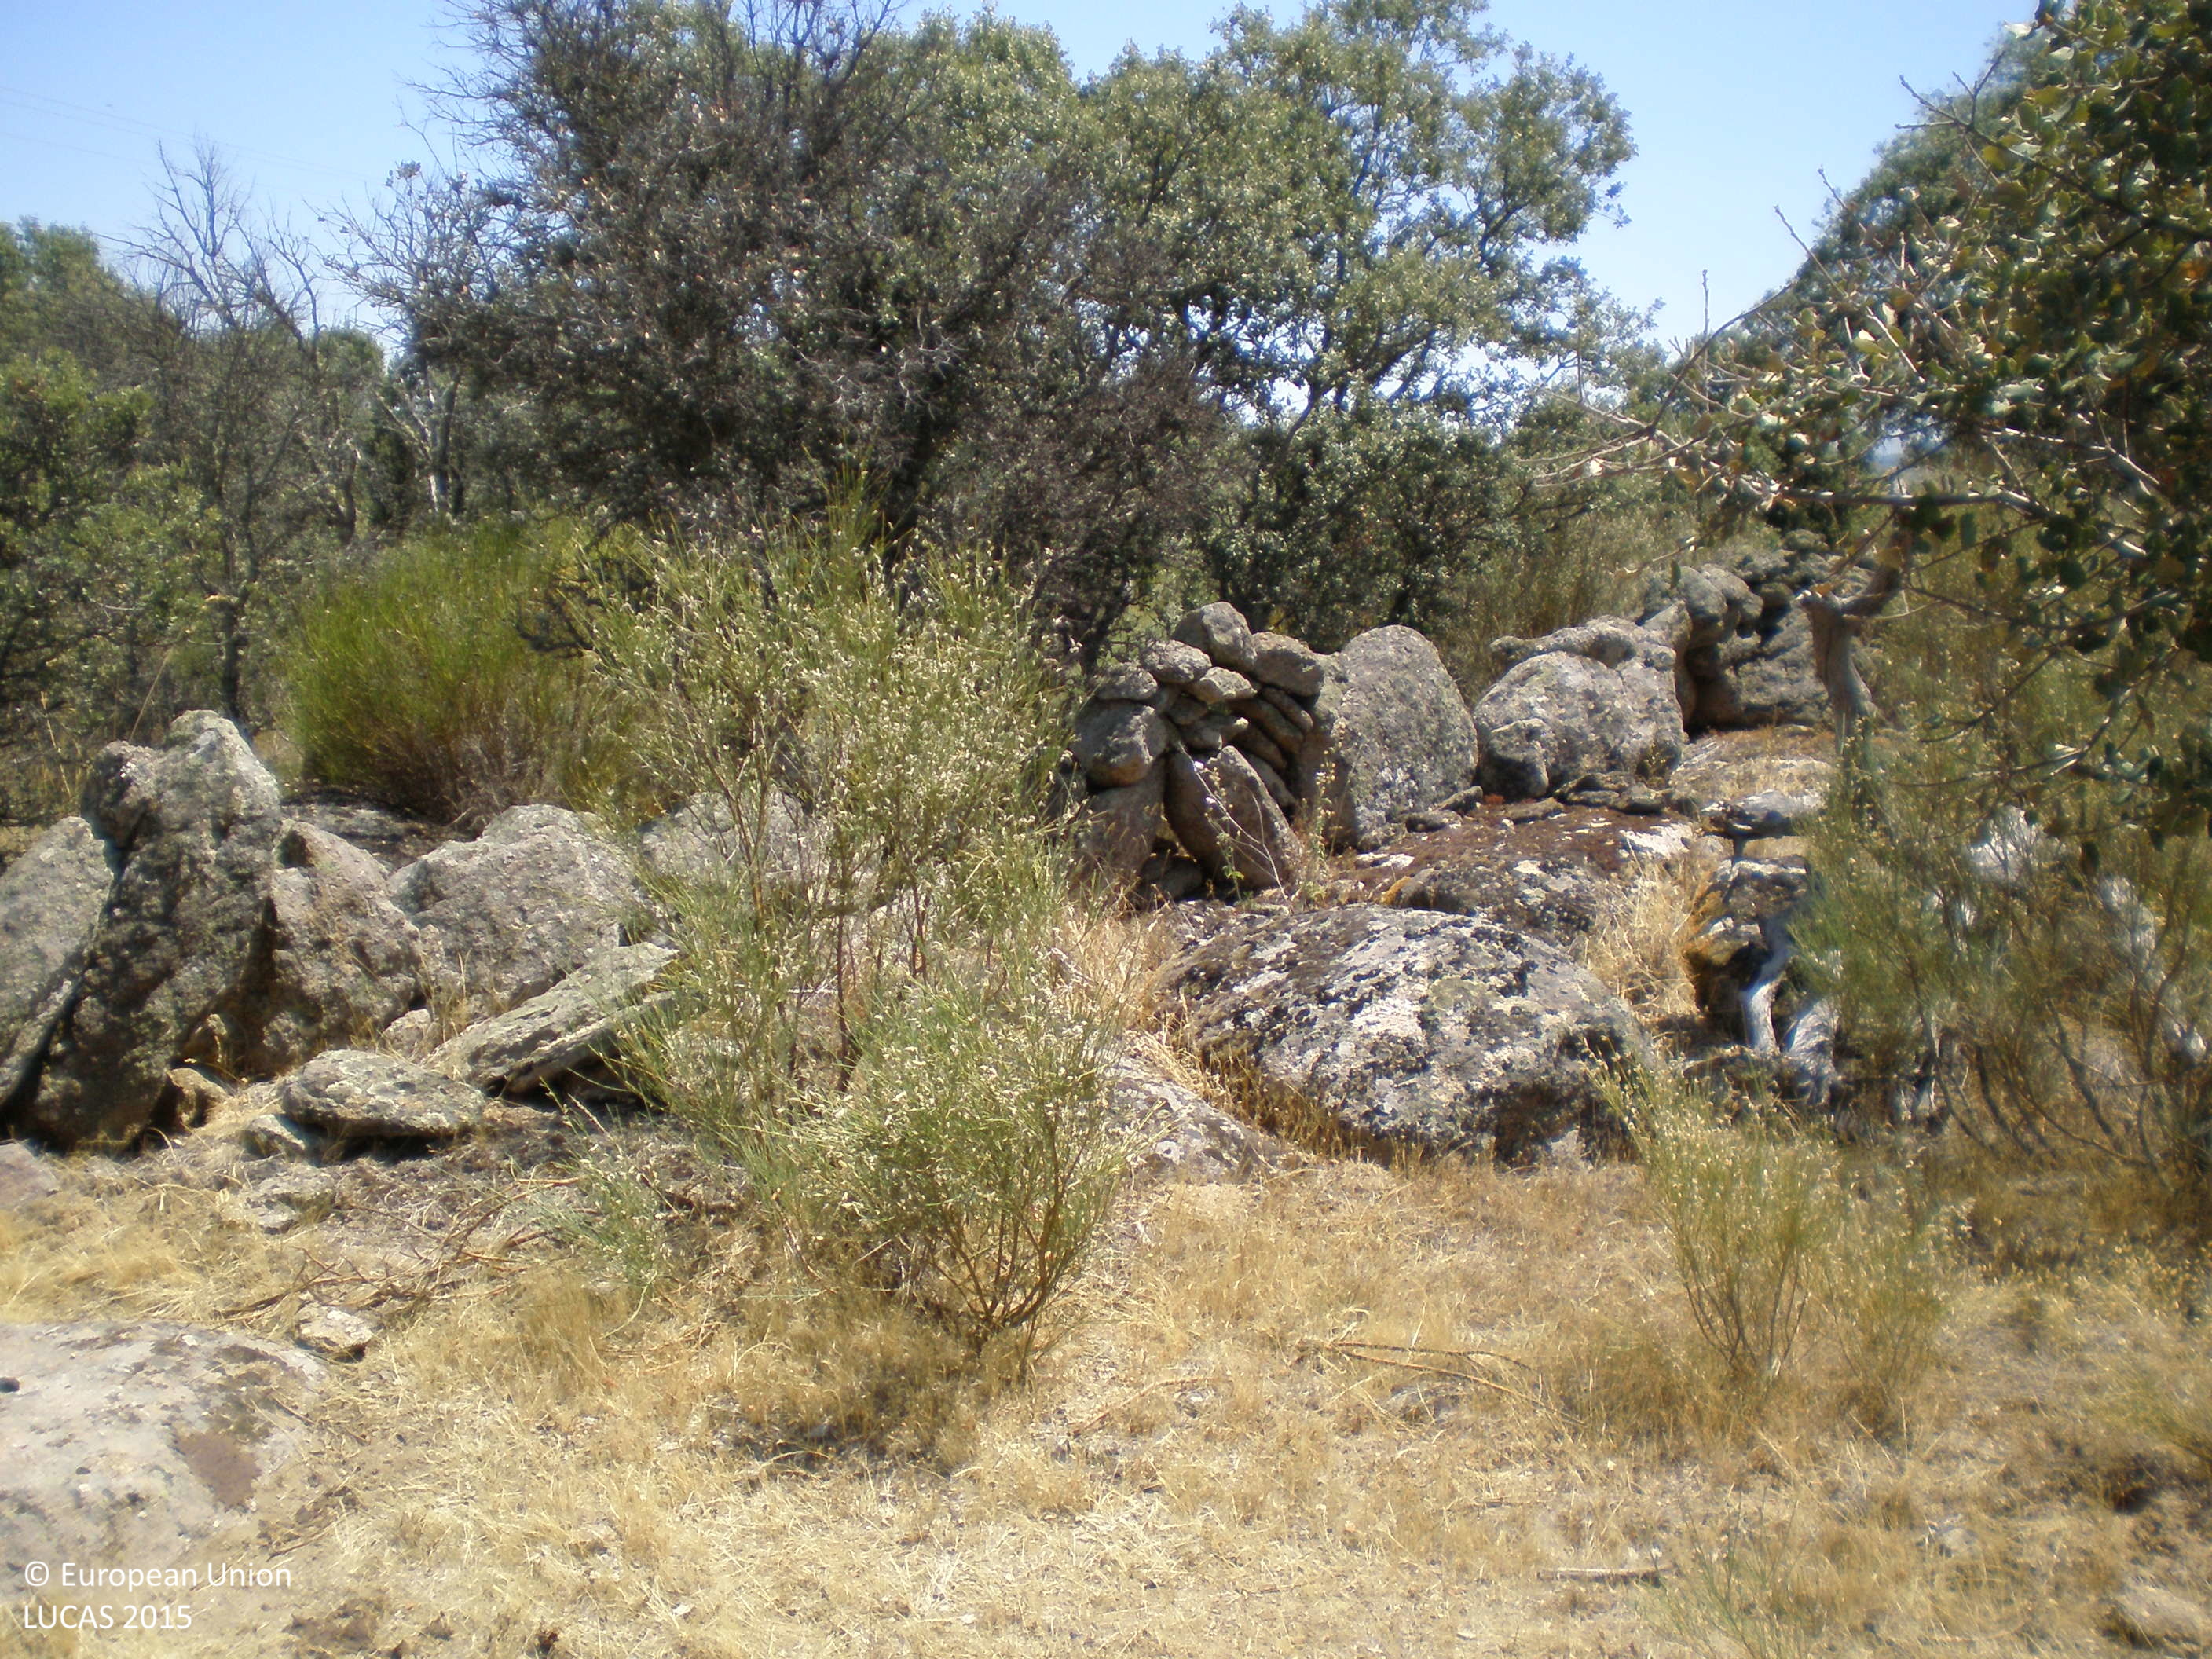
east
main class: Woodland
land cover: Broadleaved woodland
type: broadleaved evergreen forest
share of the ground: 25 - 50 %
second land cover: Grassland without tree/shrub cover
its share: 50 - 75 %
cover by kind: herbaceous plants 70 %, broadleaved forest trees 30 %
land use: Forestry
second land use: Agriculture (excluding fallow land and kitchen gardens)
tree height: > 5 m
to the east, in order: Broadleaved woodland; Grassland without tree/shrub cover; Dry stone walls; Broadleaved woodland; Tracks; Broadleaved woodland; Dry stone walls; Broadleaved woodland
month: July
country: ES
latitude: 40.4211
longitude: -5.5179
